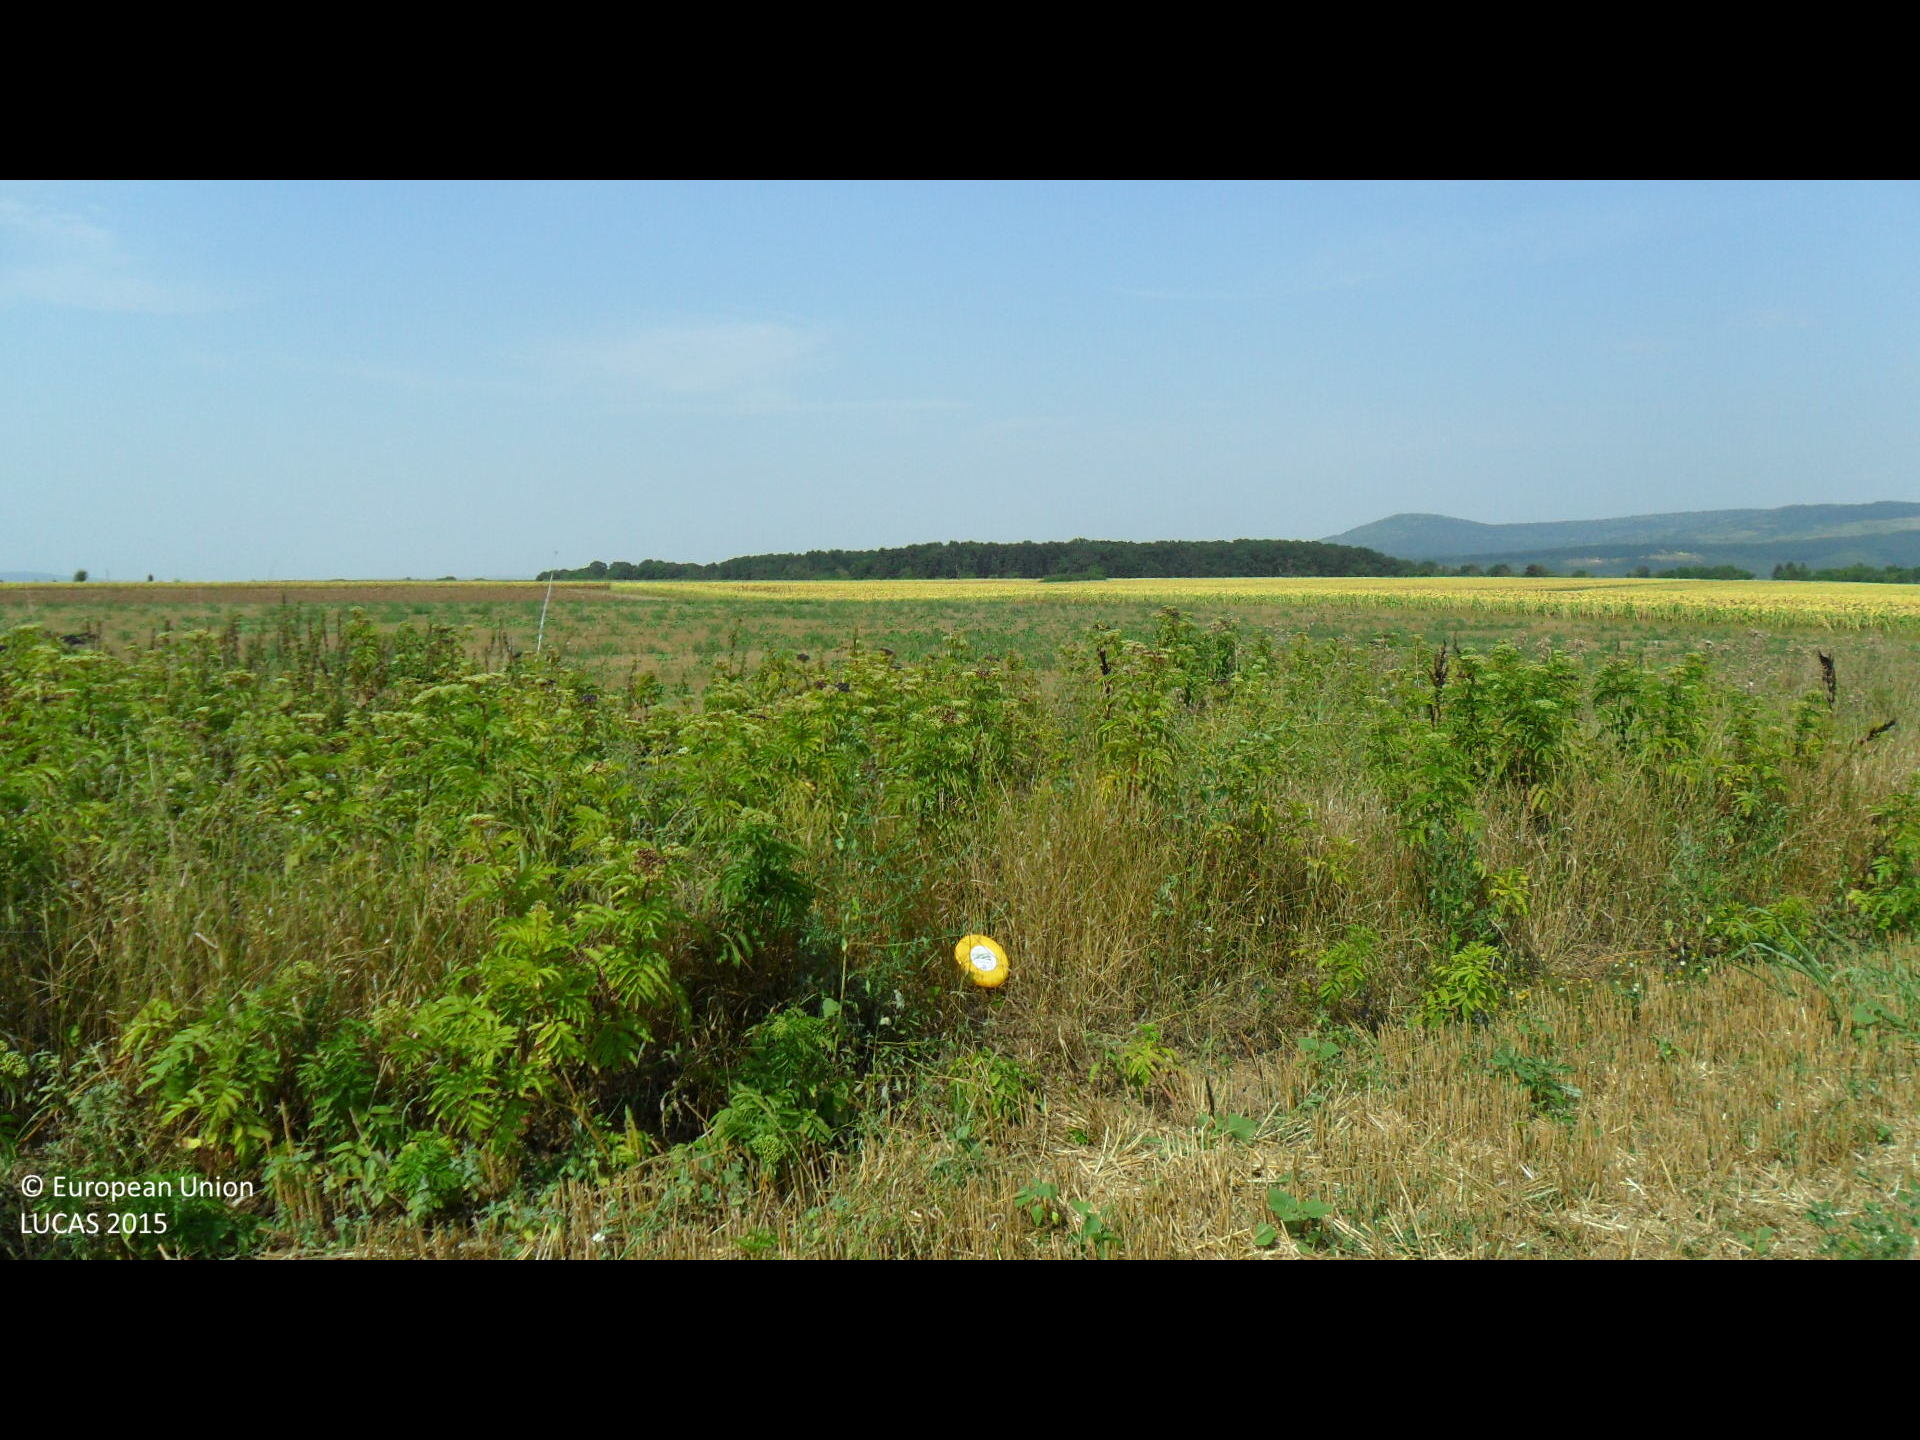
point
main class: Grassland
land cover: Spontaneously vegetated surfaces
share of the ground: > 75 %
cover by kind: herbaceous plants 100 %
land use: Semi-natural and natural areas not in use
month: August
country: BG
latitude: 43.3147
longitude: 26.2611
